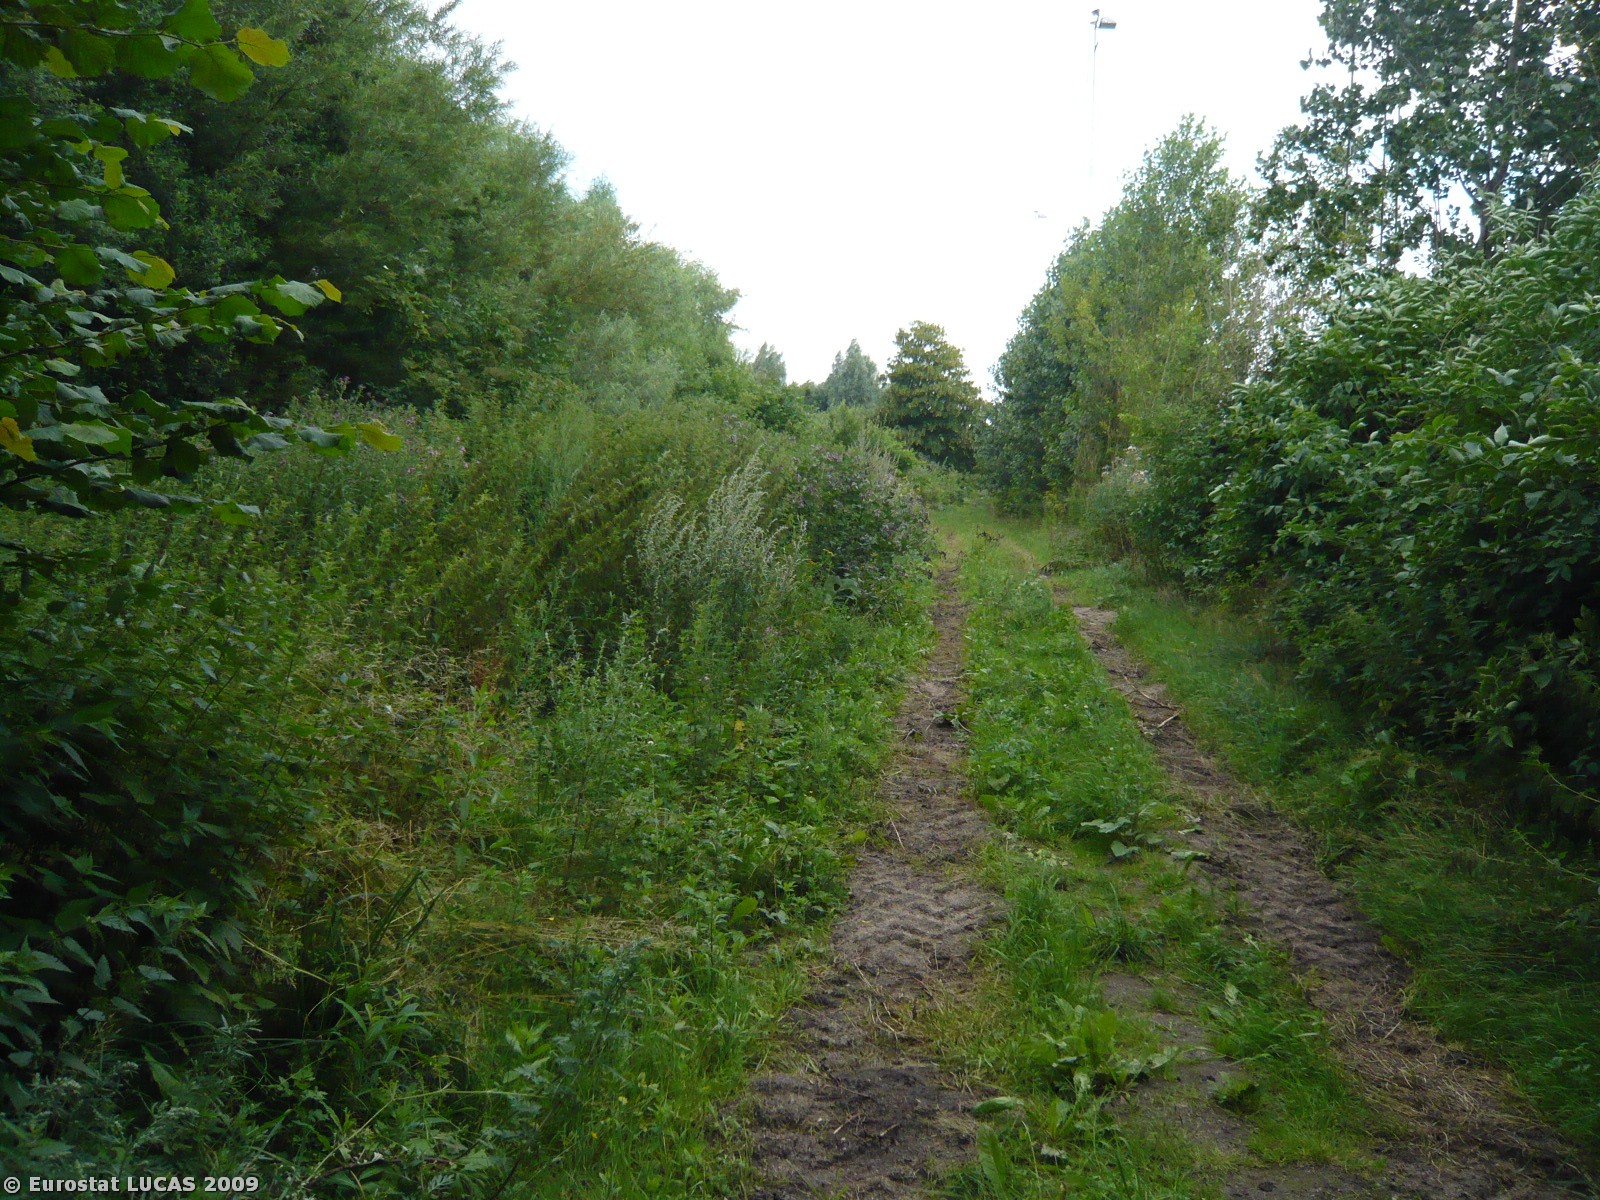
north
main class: Woodland
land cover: Broadleaved woodland
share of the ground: > 75 %
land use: Unused
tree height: < 5 m
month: July
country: DK
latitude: 55.4862
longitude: 12.1663
